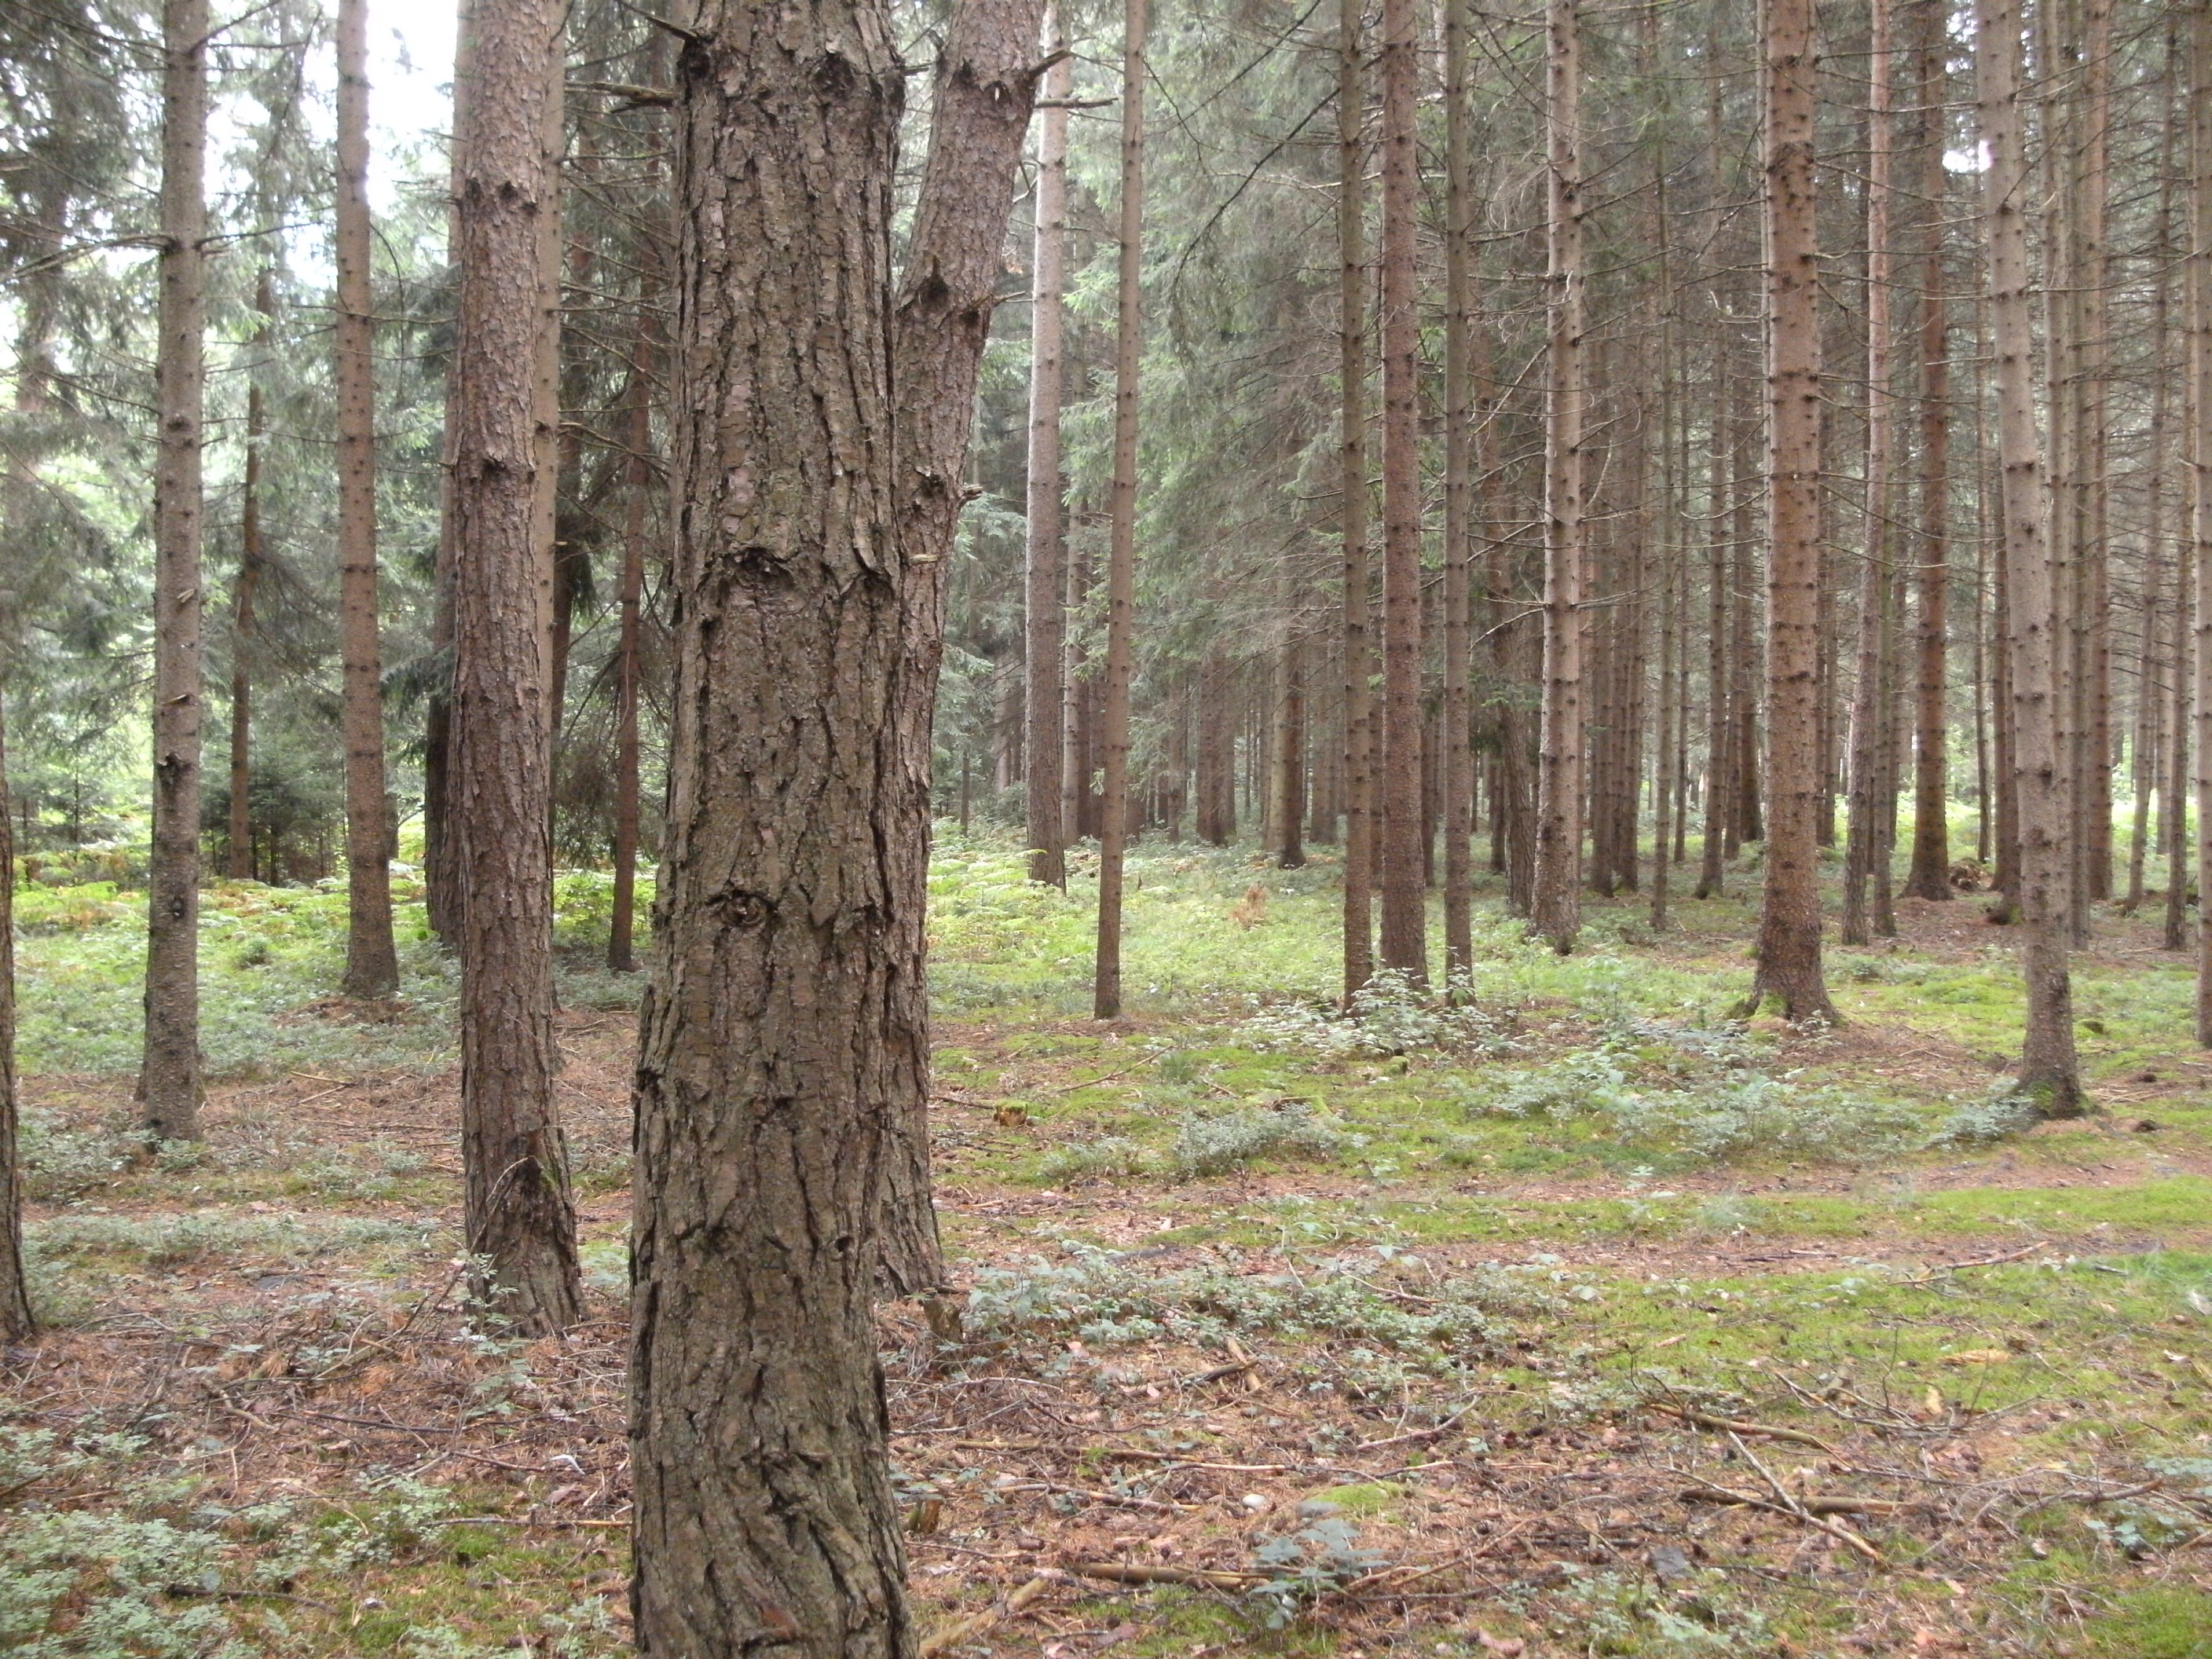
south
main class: Woodland
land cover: Other coniferous woodland
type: hemiboreal forest and nemoral coniferous forest and mixed broadleaved-coniferous forest
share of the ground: > 75 %
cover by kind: coniferous forest trees 85 %, shrubs 5 %, herbaceous plants 5 %, unconsolidated bare surface 5 %
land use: Forestry
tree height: > 5 m
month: July
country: AT
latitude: 46.6082
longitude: 14.7111
